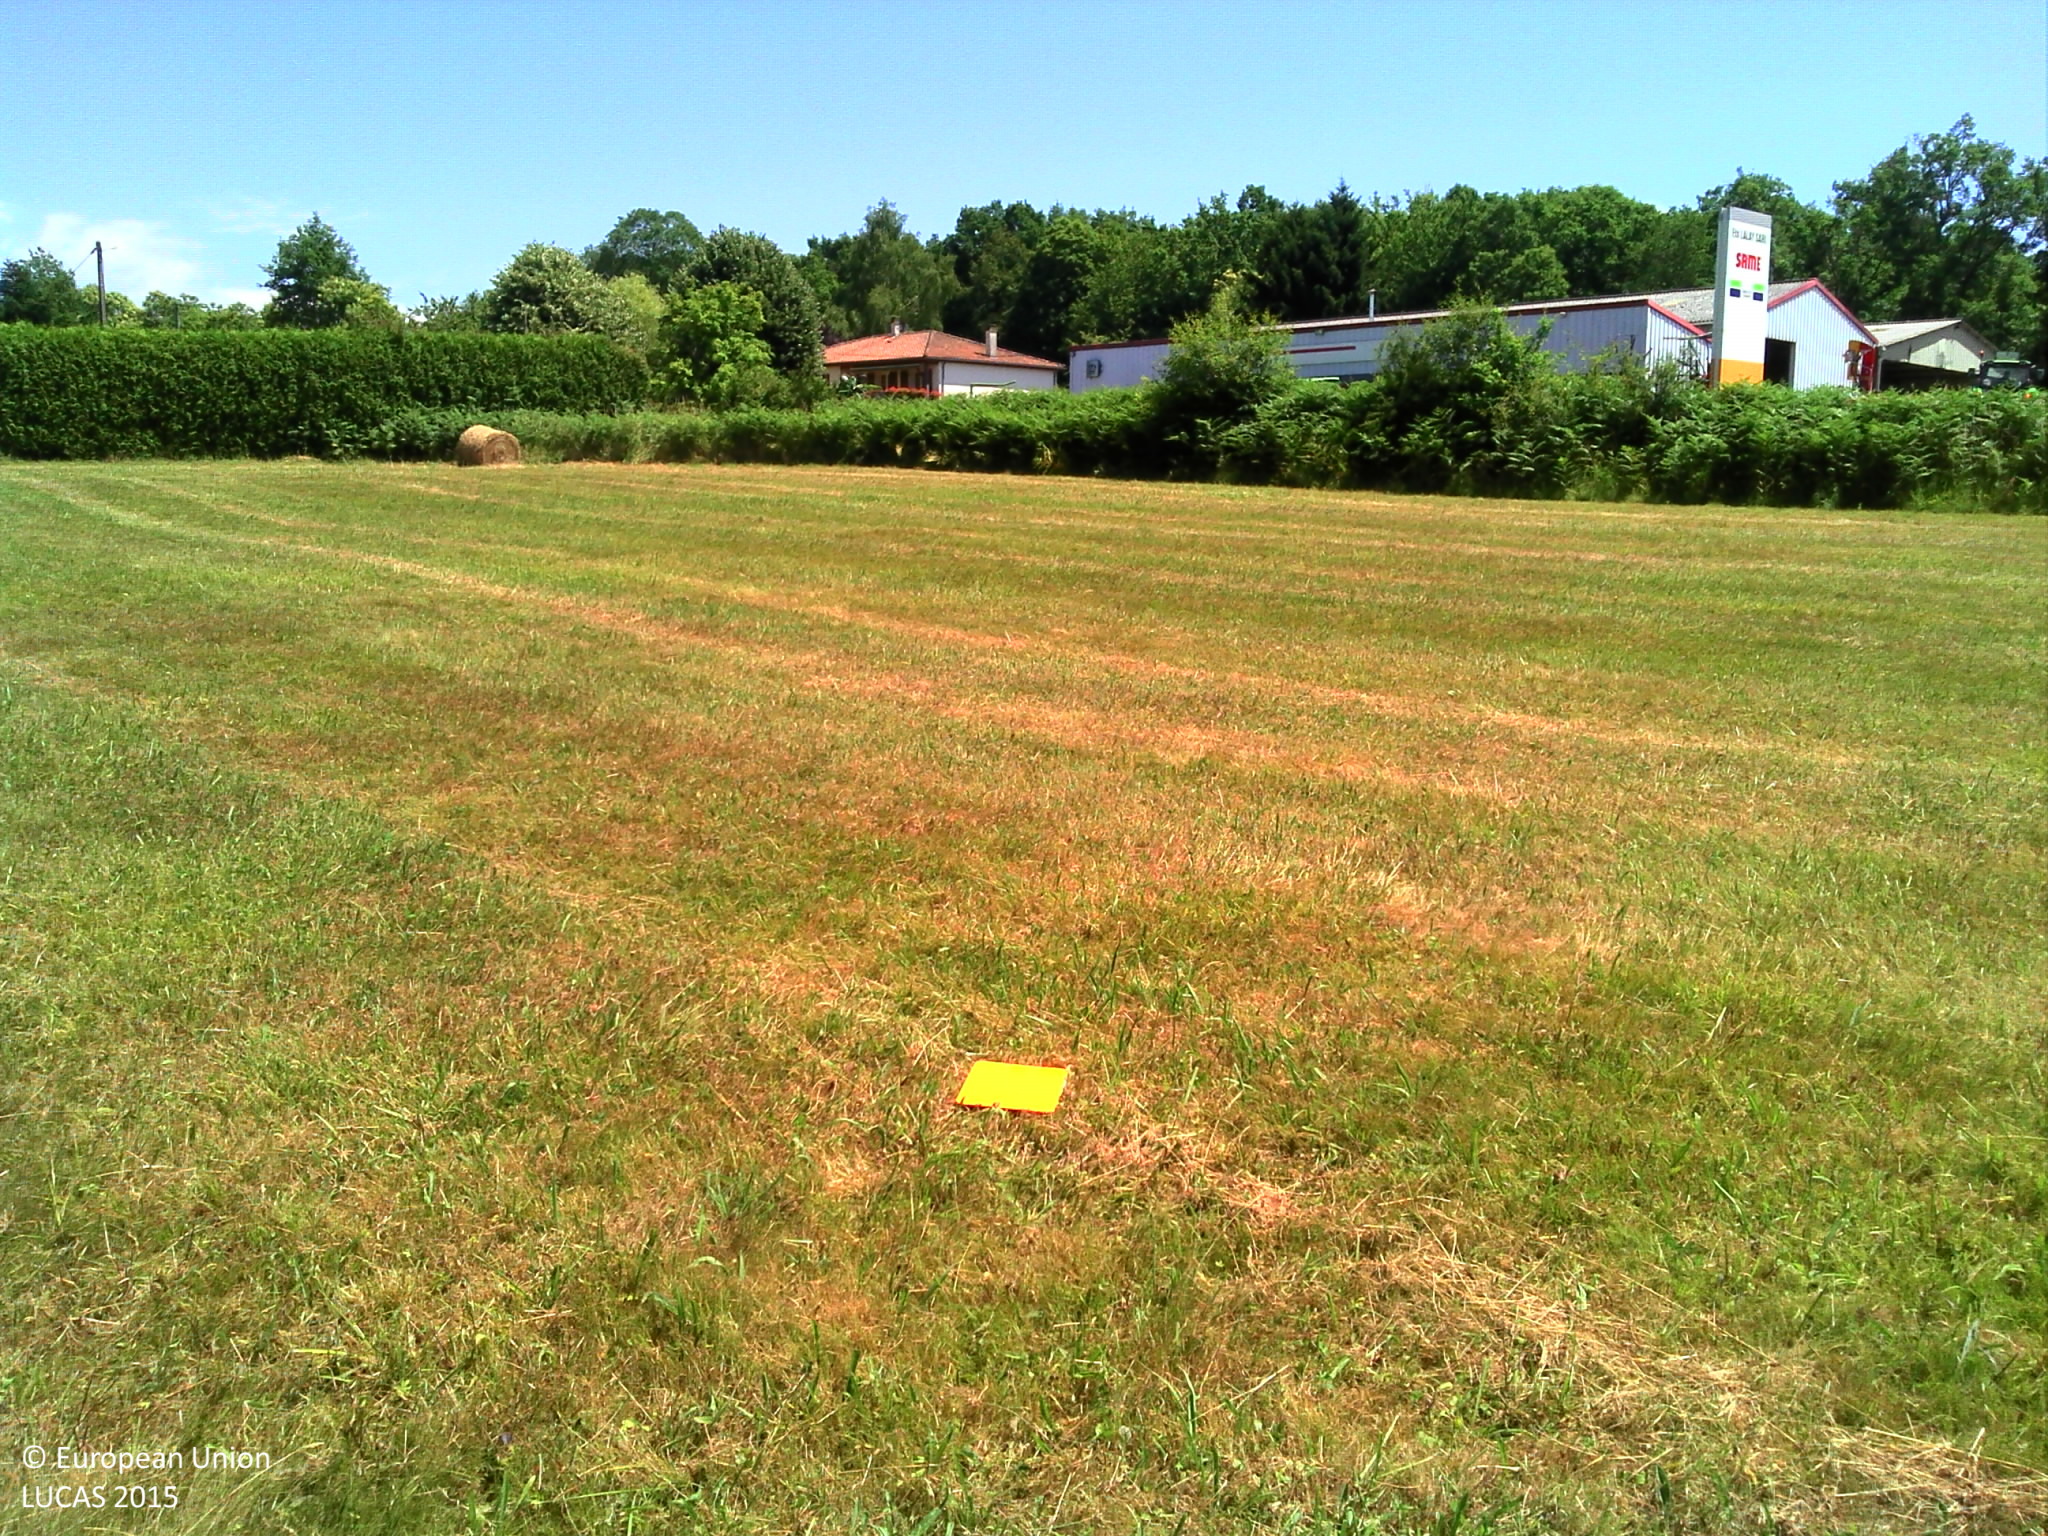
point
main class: Grassland
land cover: Grassland without tree/shrub cover
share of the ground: > 75 %
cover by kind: herbaceous plants 100 %
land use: Agriculture (excluding fallow land and kitchen gardens)
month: June
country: FR
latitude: 45.7811
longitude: 0.6880
